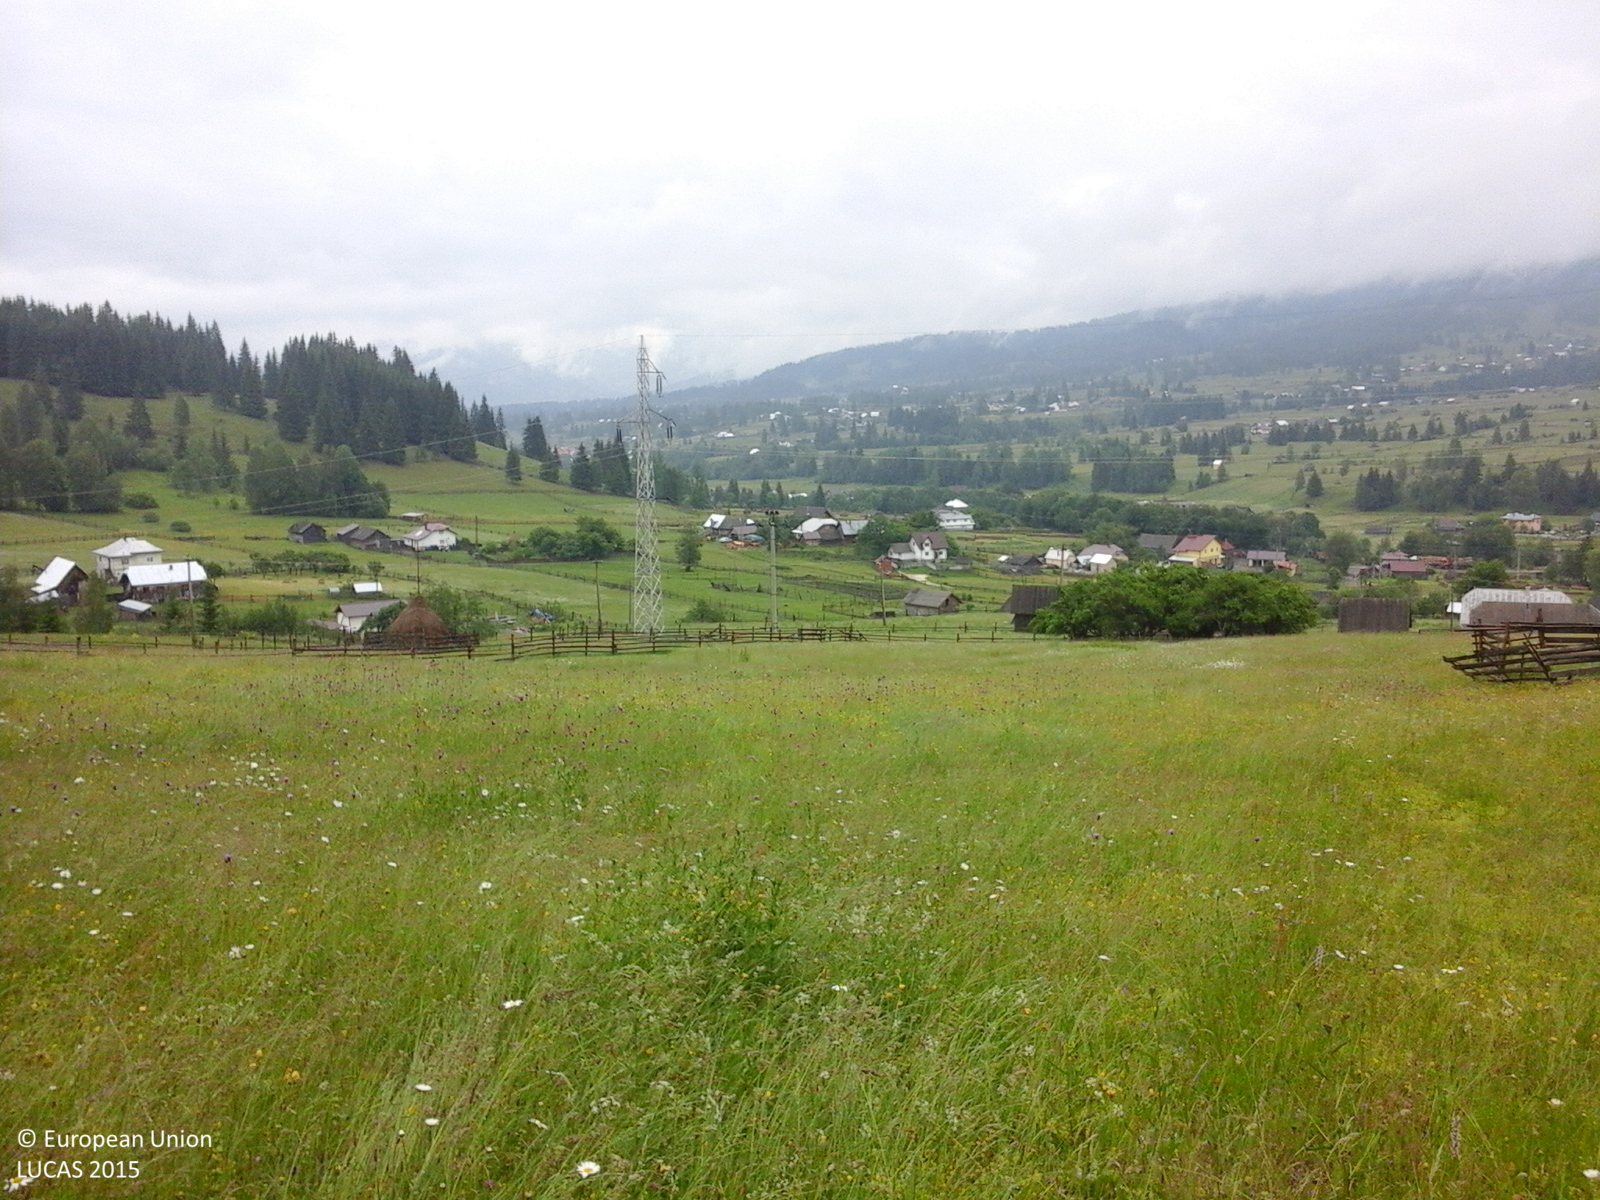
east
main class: Grassland
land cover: Grassland without tree/shrub cover
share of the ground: > 75 %
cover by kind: herbaceous plants 100 %
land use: Agriculture (excluding fallow land and kitchen gardens)
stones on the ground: < 10 %
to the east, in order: Grassland without tree/shrub cover; Fences; Grassland without tree/shrub cover; Tracks; Grassland without tree/shrub cover; Fences; Grassland without tree/shrub cover; Fences; Grassland without tree/shrub cover; Electric lines; Grassland without tree/shrub cover; Electric lines; Grassland without tree/shrub cover; Fences; Grassland without tree/shrub cover; Electric lines; Grassland without tree/shrub cover; Fences; Grassland without tree/shrub cover; Grassland with sparse tree/shrub cover; Rivers and streams; Fences; Grassland with sparse tree/shrub cover; Paved roads, cycling and walking lanes; Grass margins; Fences; Spontaneously vegetated surfaces; Fences; Grassland without tree/shrub cover
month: June
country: RO
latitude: 47.2230
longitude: 25.2828
